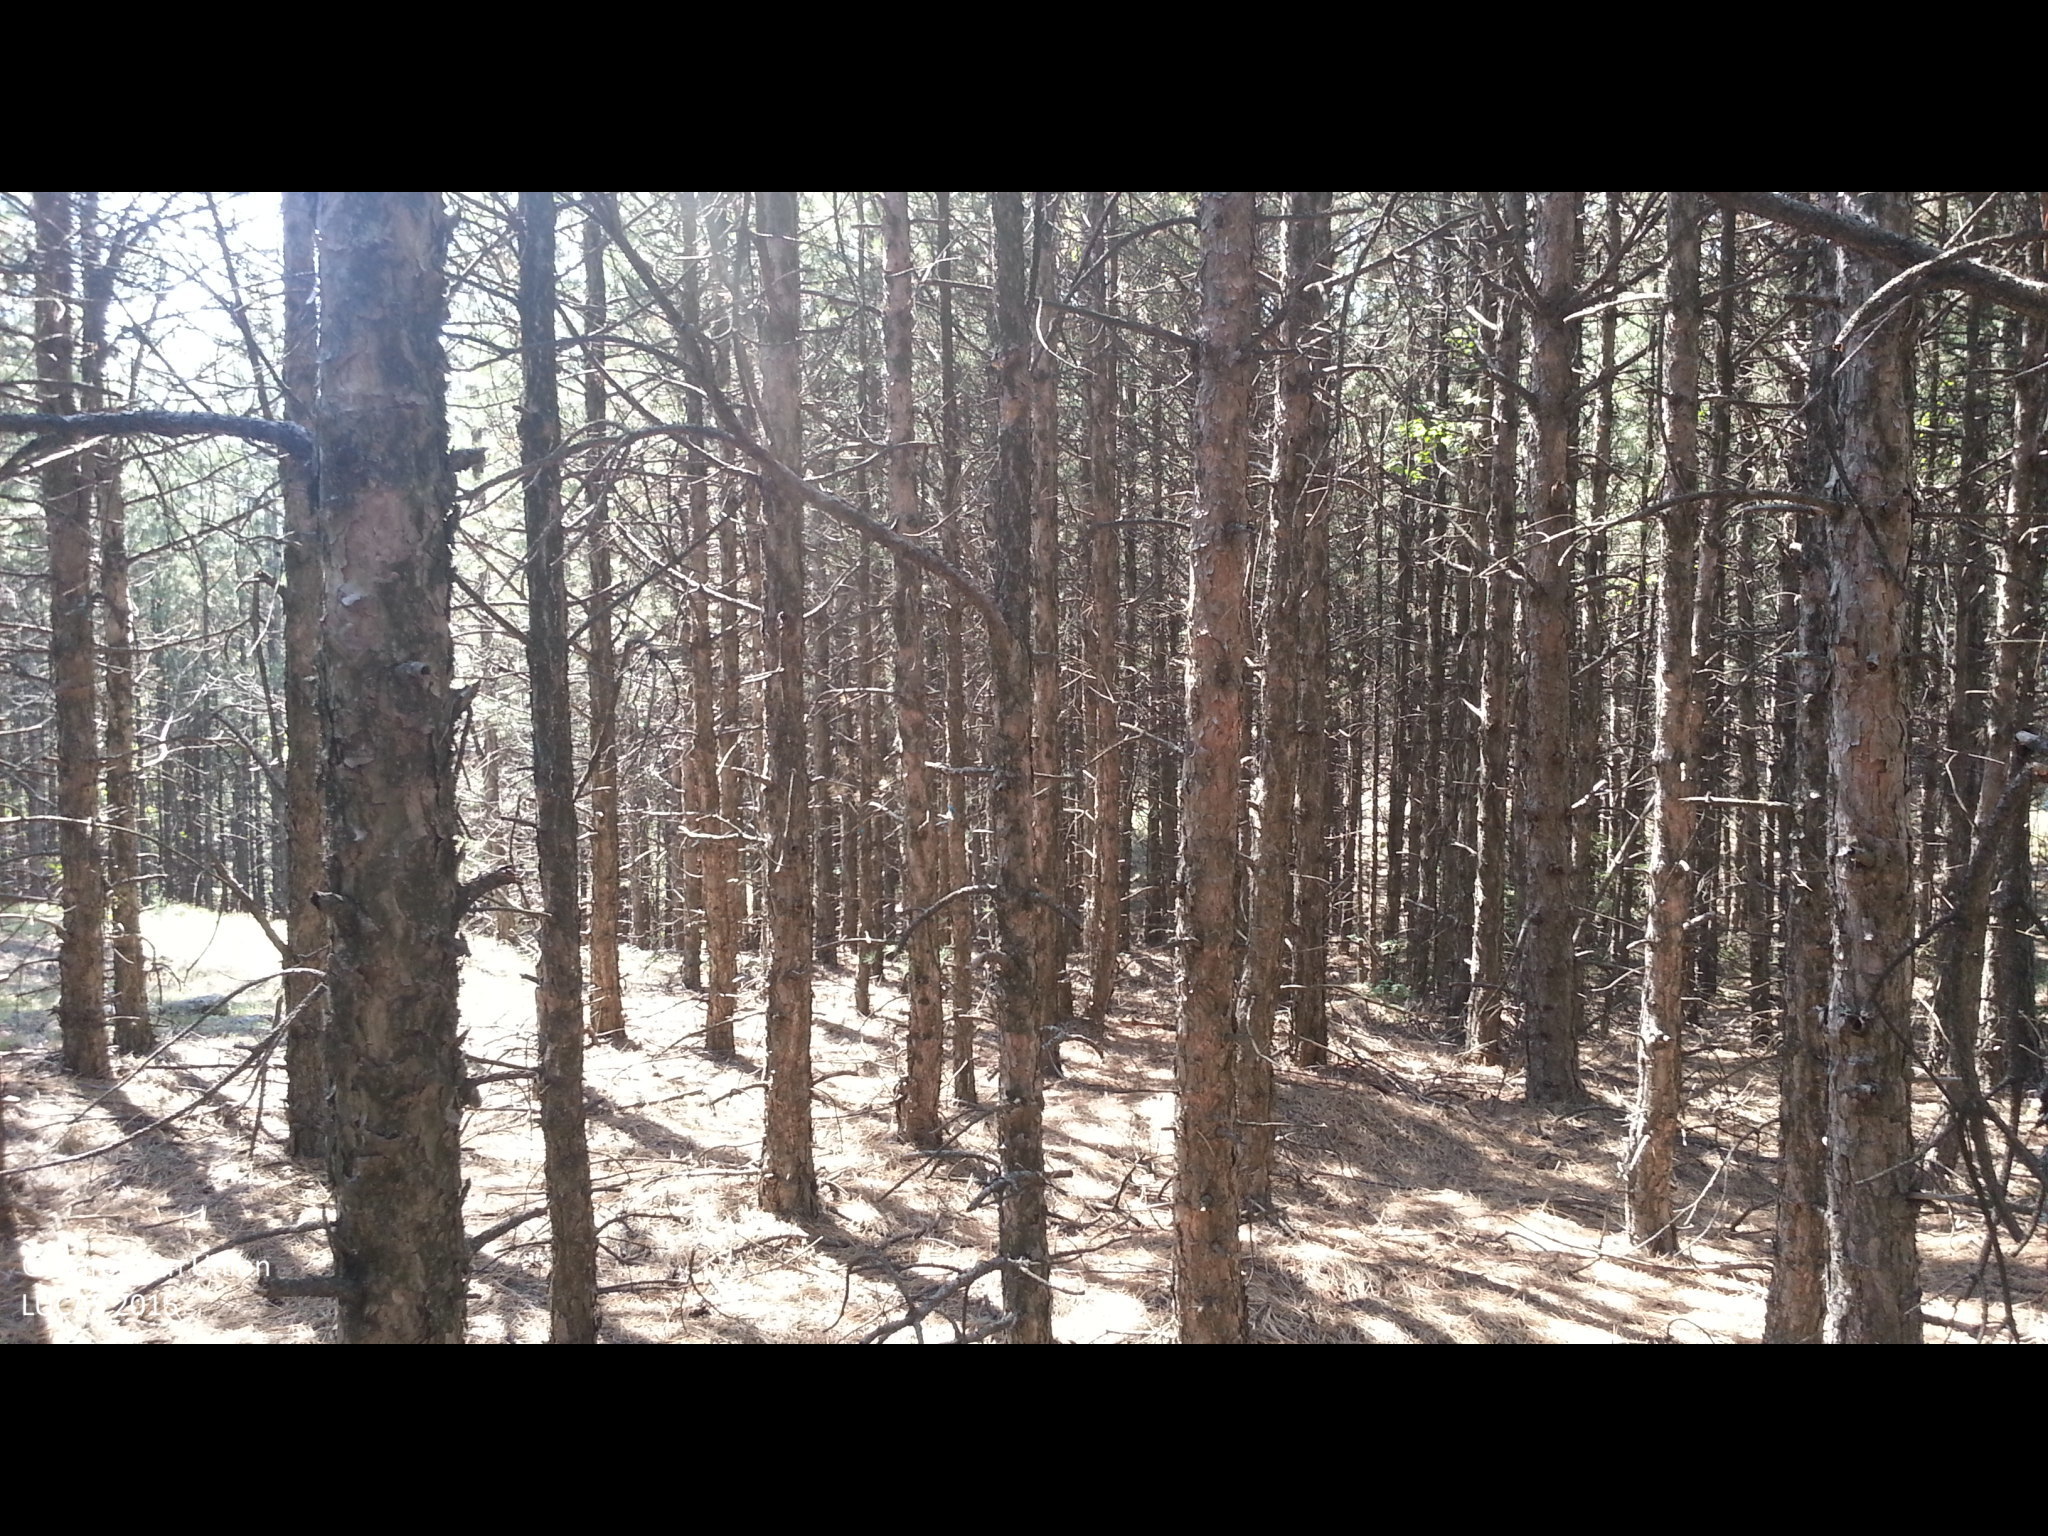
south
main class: Woodland
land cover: Pine dominated coniferous woodland
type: hemiboreal forest and nemoral coniferous forest and mixed broadleaved-coniferous forest
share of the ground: > 75 %
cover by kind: coniferous forest trees 100 %
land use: Forestry
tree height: > 5 m
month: August
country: BG
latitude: 42.5069
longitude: 23.1367
